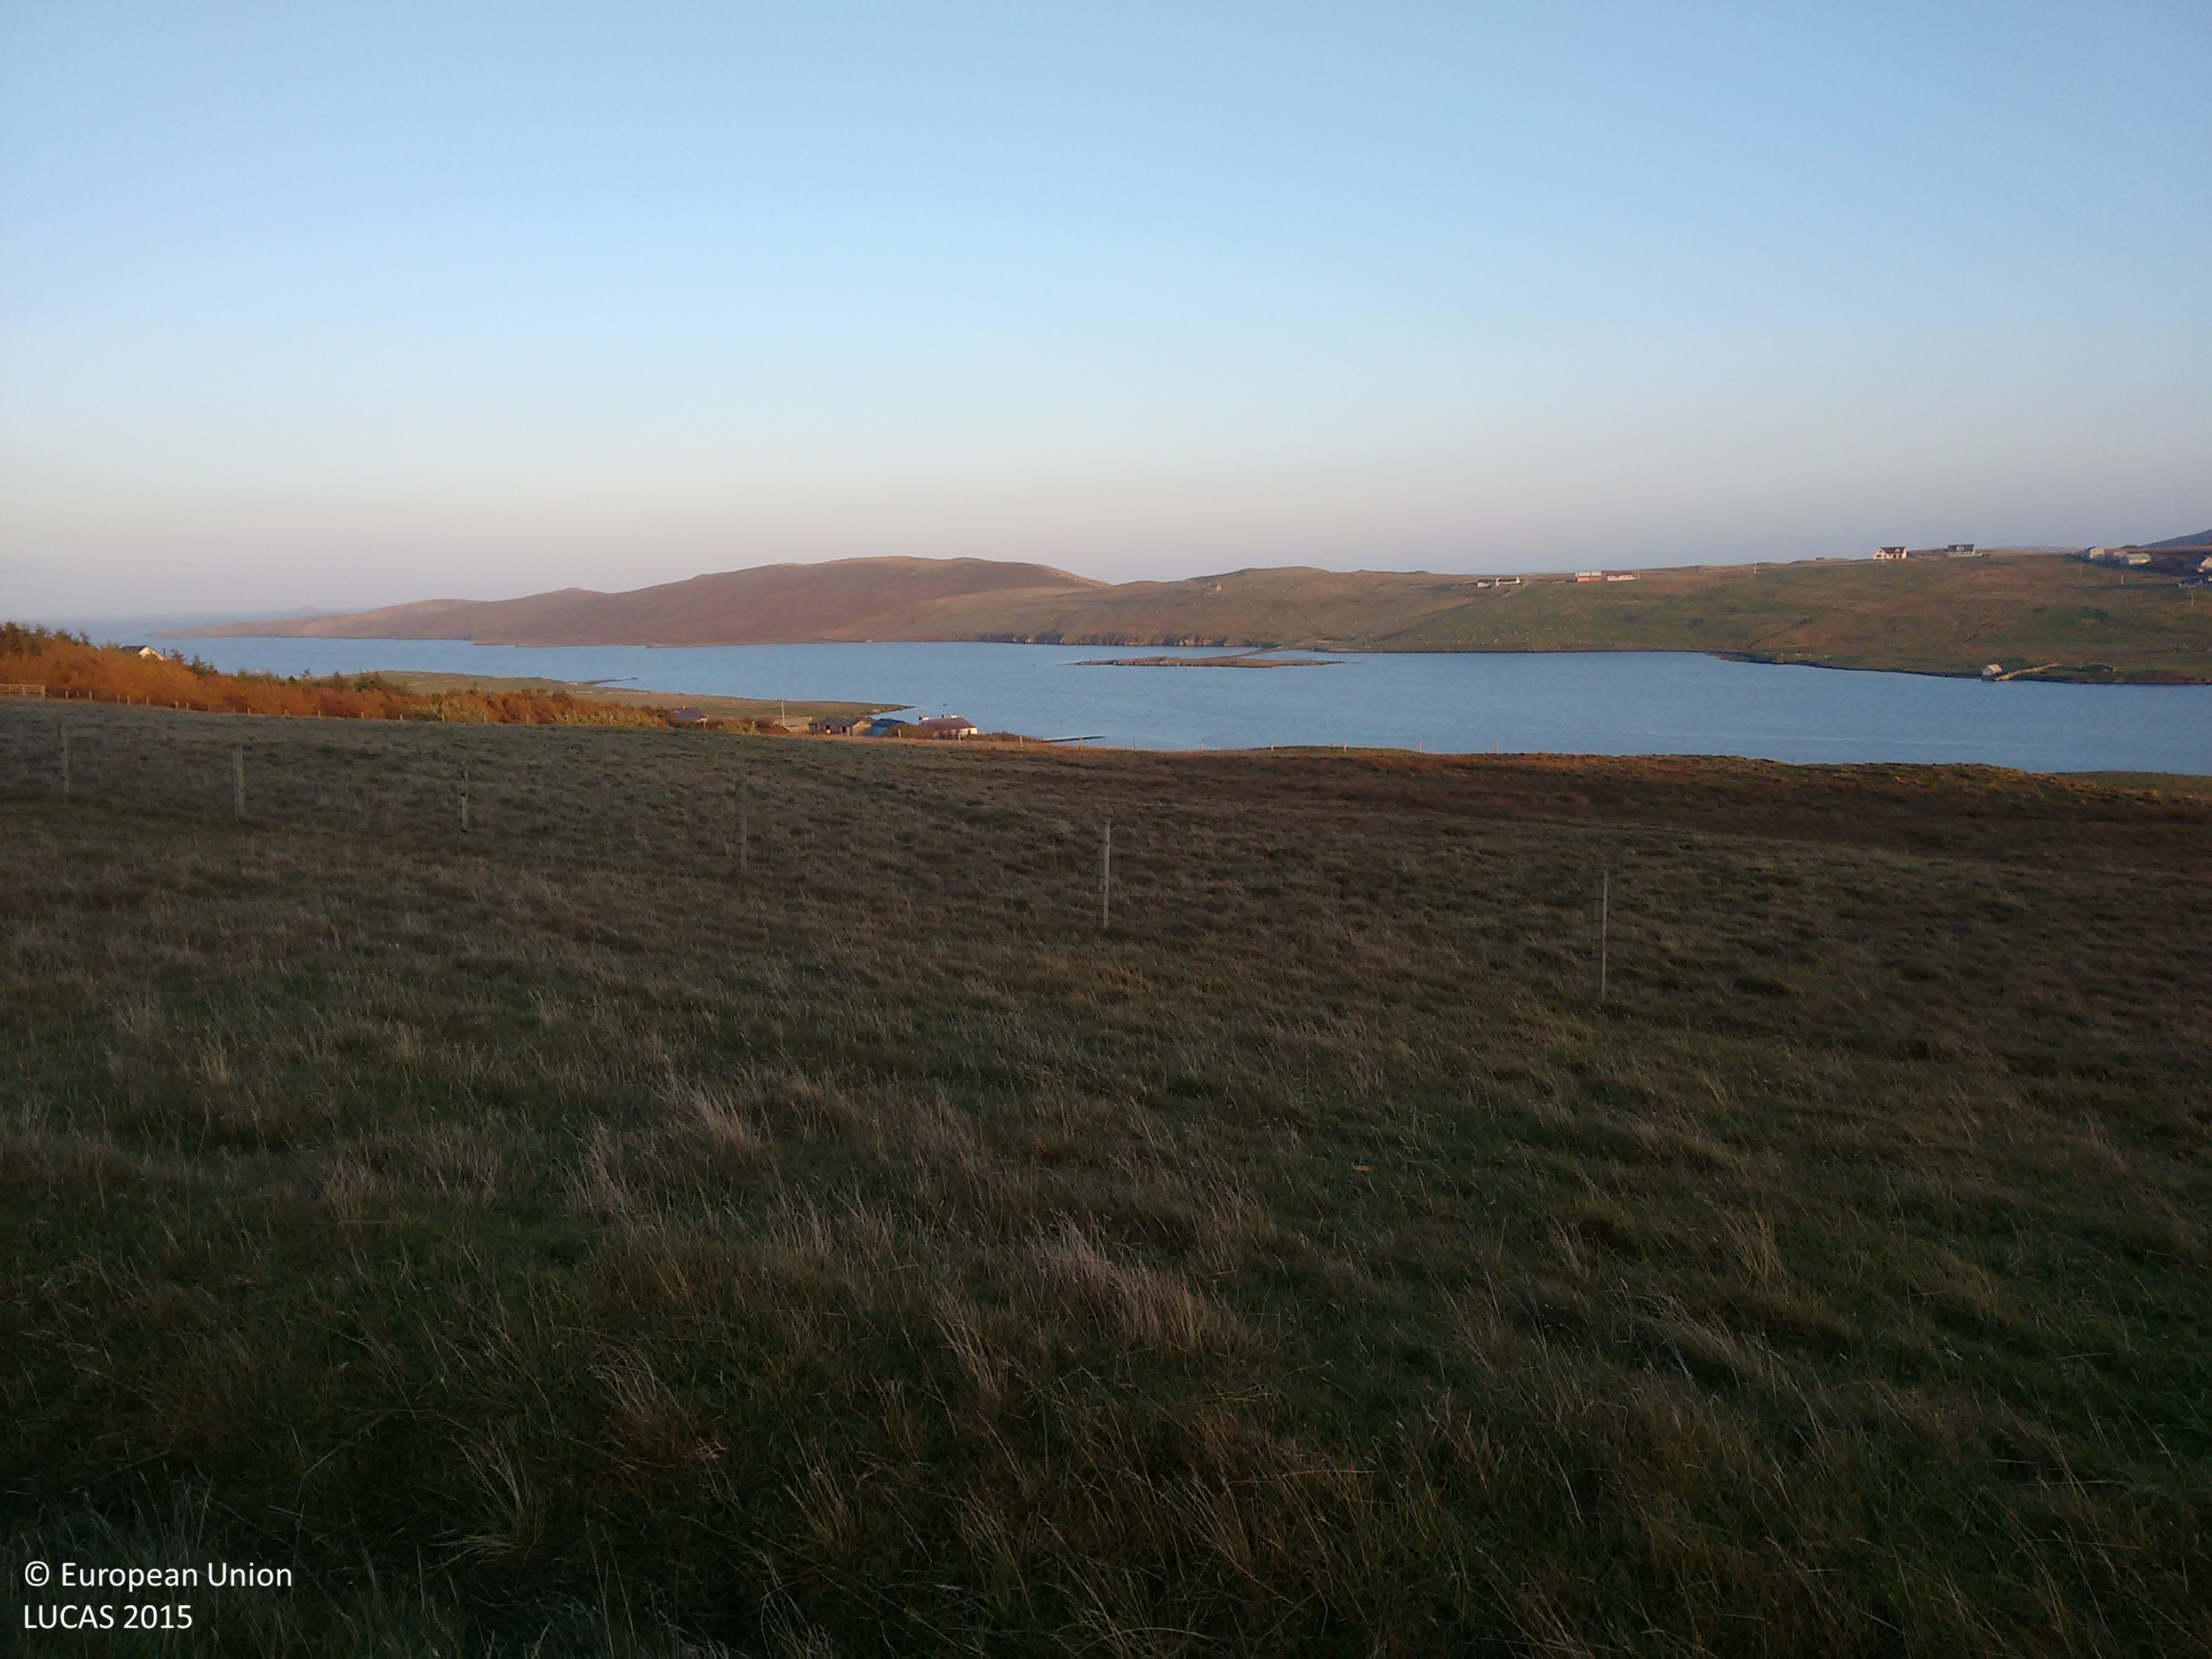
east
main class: Grassland
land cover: Grassland without tree/shrub cover
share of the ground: > 75 %
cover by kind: herbaceous plants 100 %
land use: Agriculture (excluding fallow land and kitchen gardens)
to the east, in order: Grassland without tree/shrub cover; Fences; Grassland without tree/shrub cover; Shrubland without tree cover; Grassland without tree/shrub cover; Fences; Grassland without tree/shrub cover; Ditches and canals; Paved roads, cycling and walking lanes; Grass margins; Dry stone walls; Grassland without tree/shrub cover
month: November
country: GB
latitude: 60.2047
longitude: -1.2230
